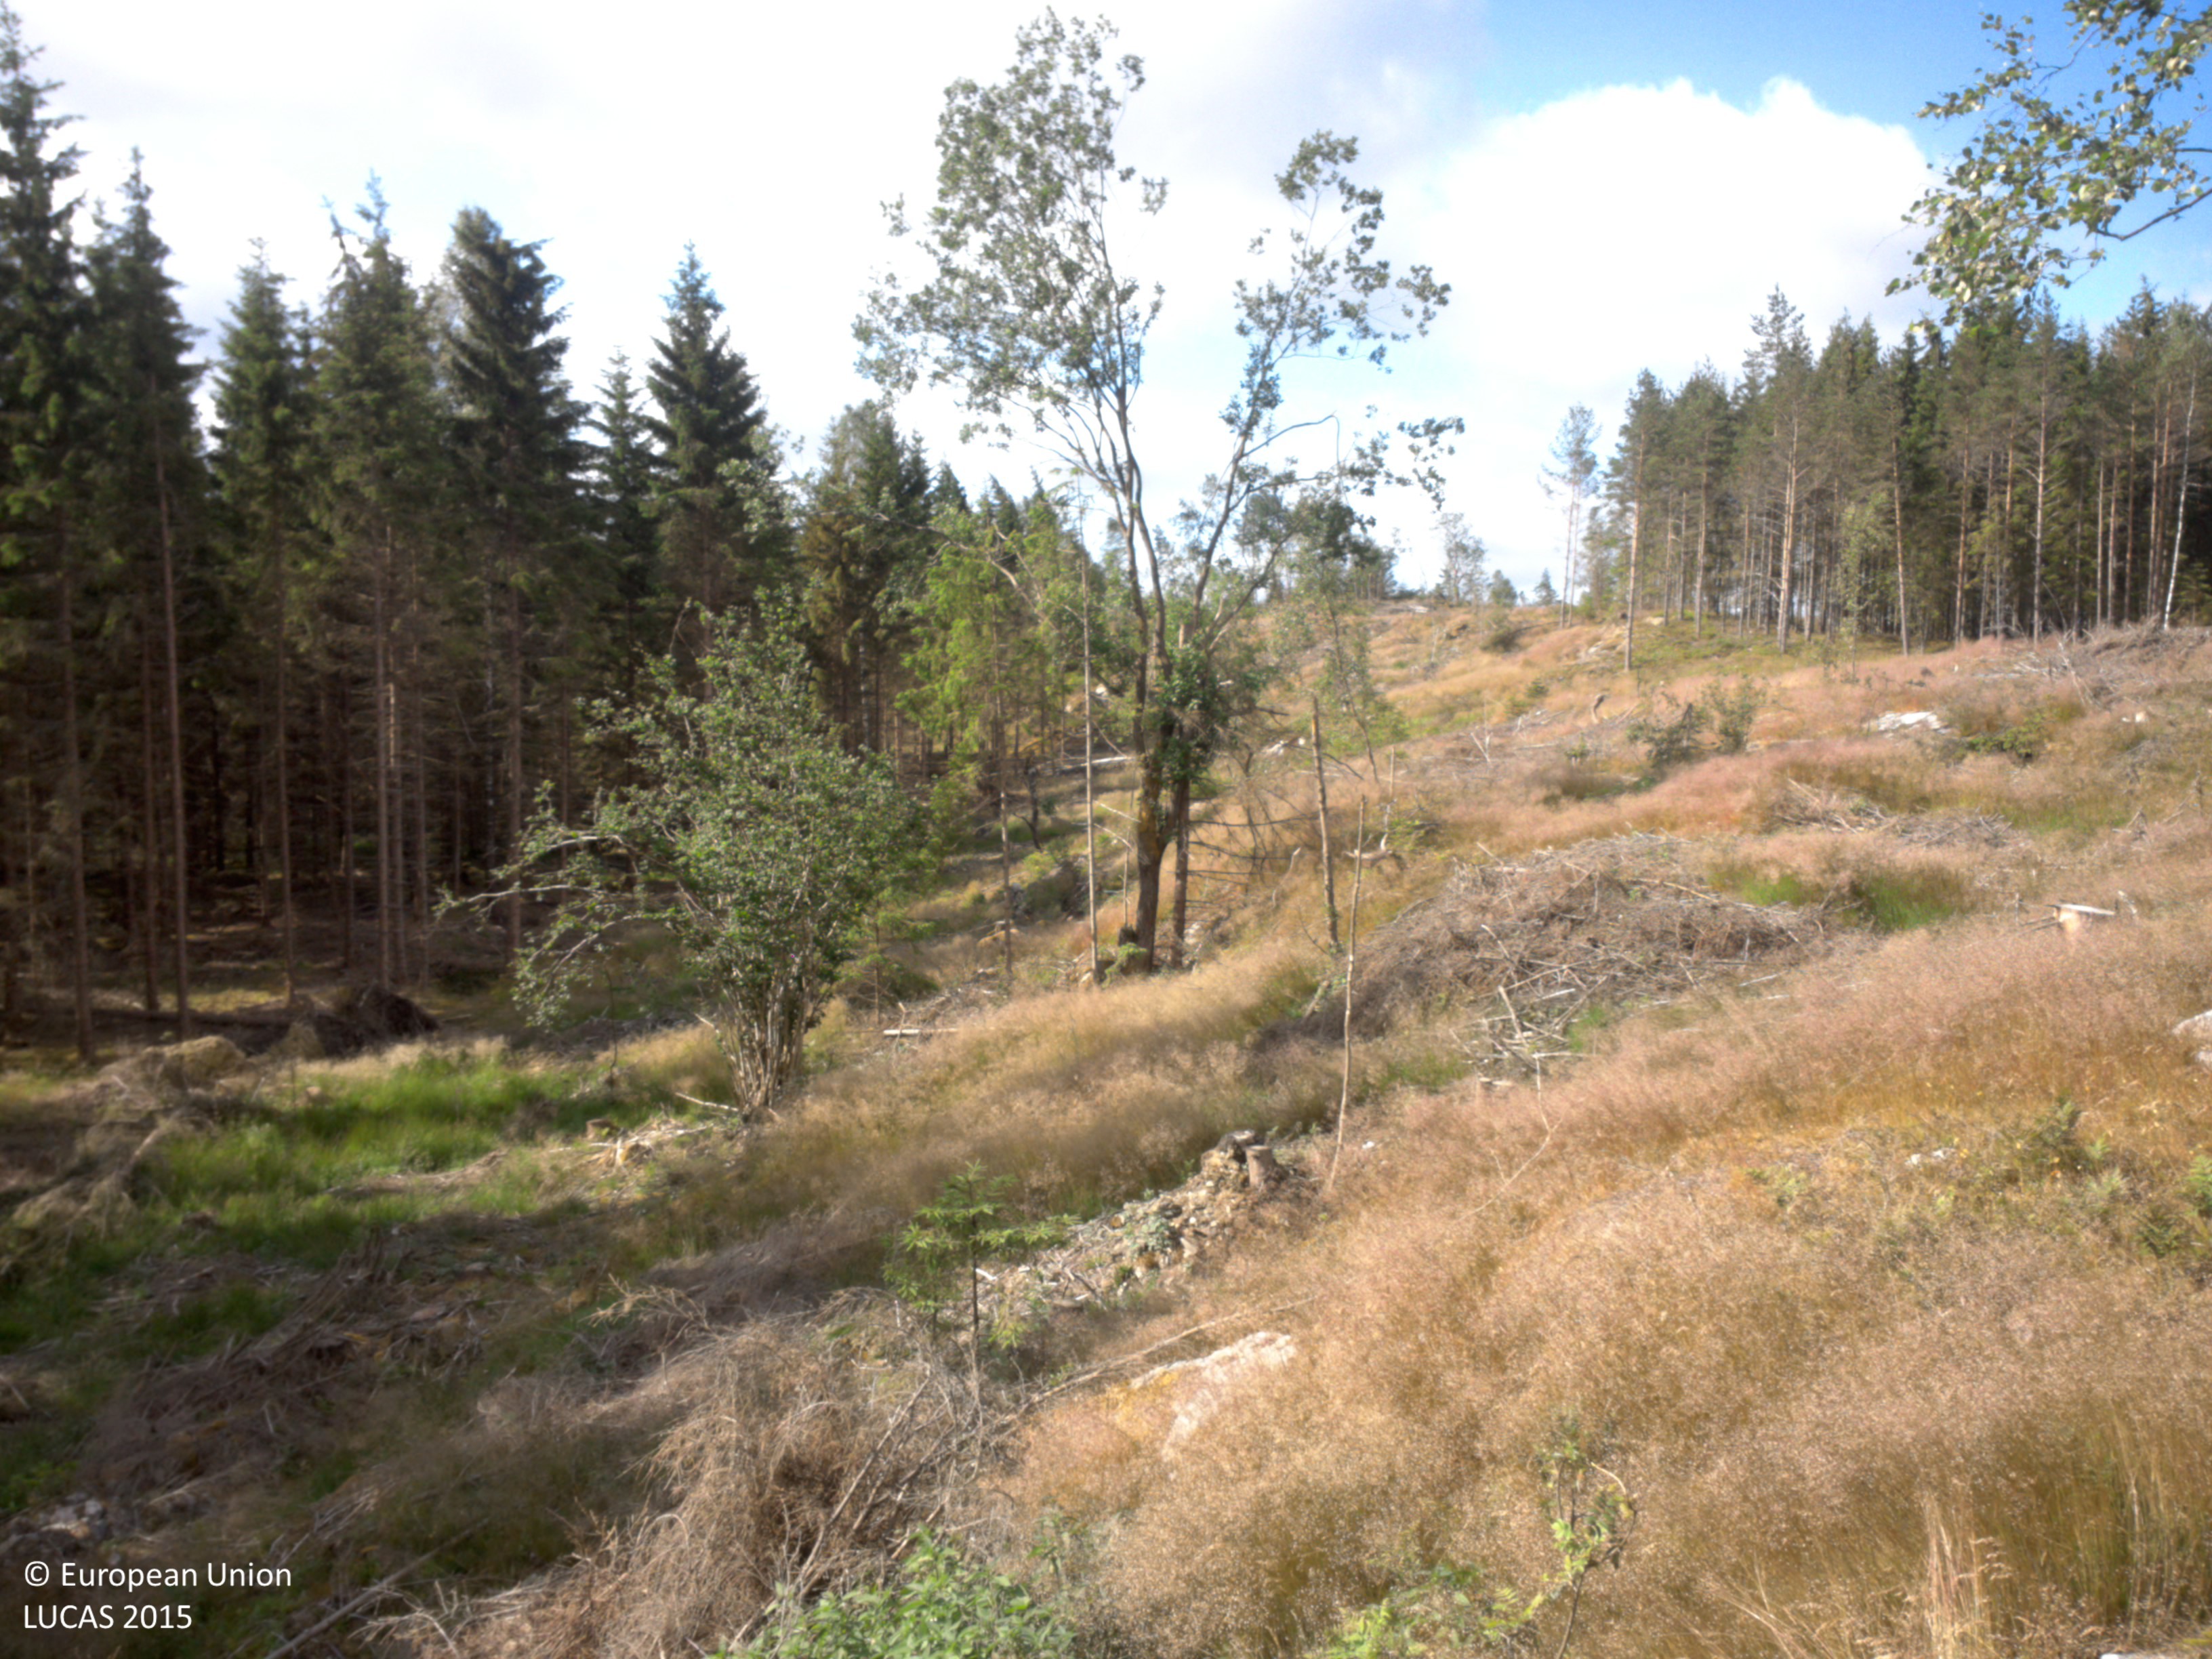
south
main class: Shrubland
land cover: Shrubland with sparse tree cover
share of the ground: 25 - 50 %
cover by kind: herbaceous plants 60 %, shrubs 30 %, broadleaved forest trees 5 %, lichens and mosses 5 %
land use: Forestry
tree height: > 5 m
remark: Clear cut
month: July
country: SE
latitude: 58.8010
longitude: 11.8132
